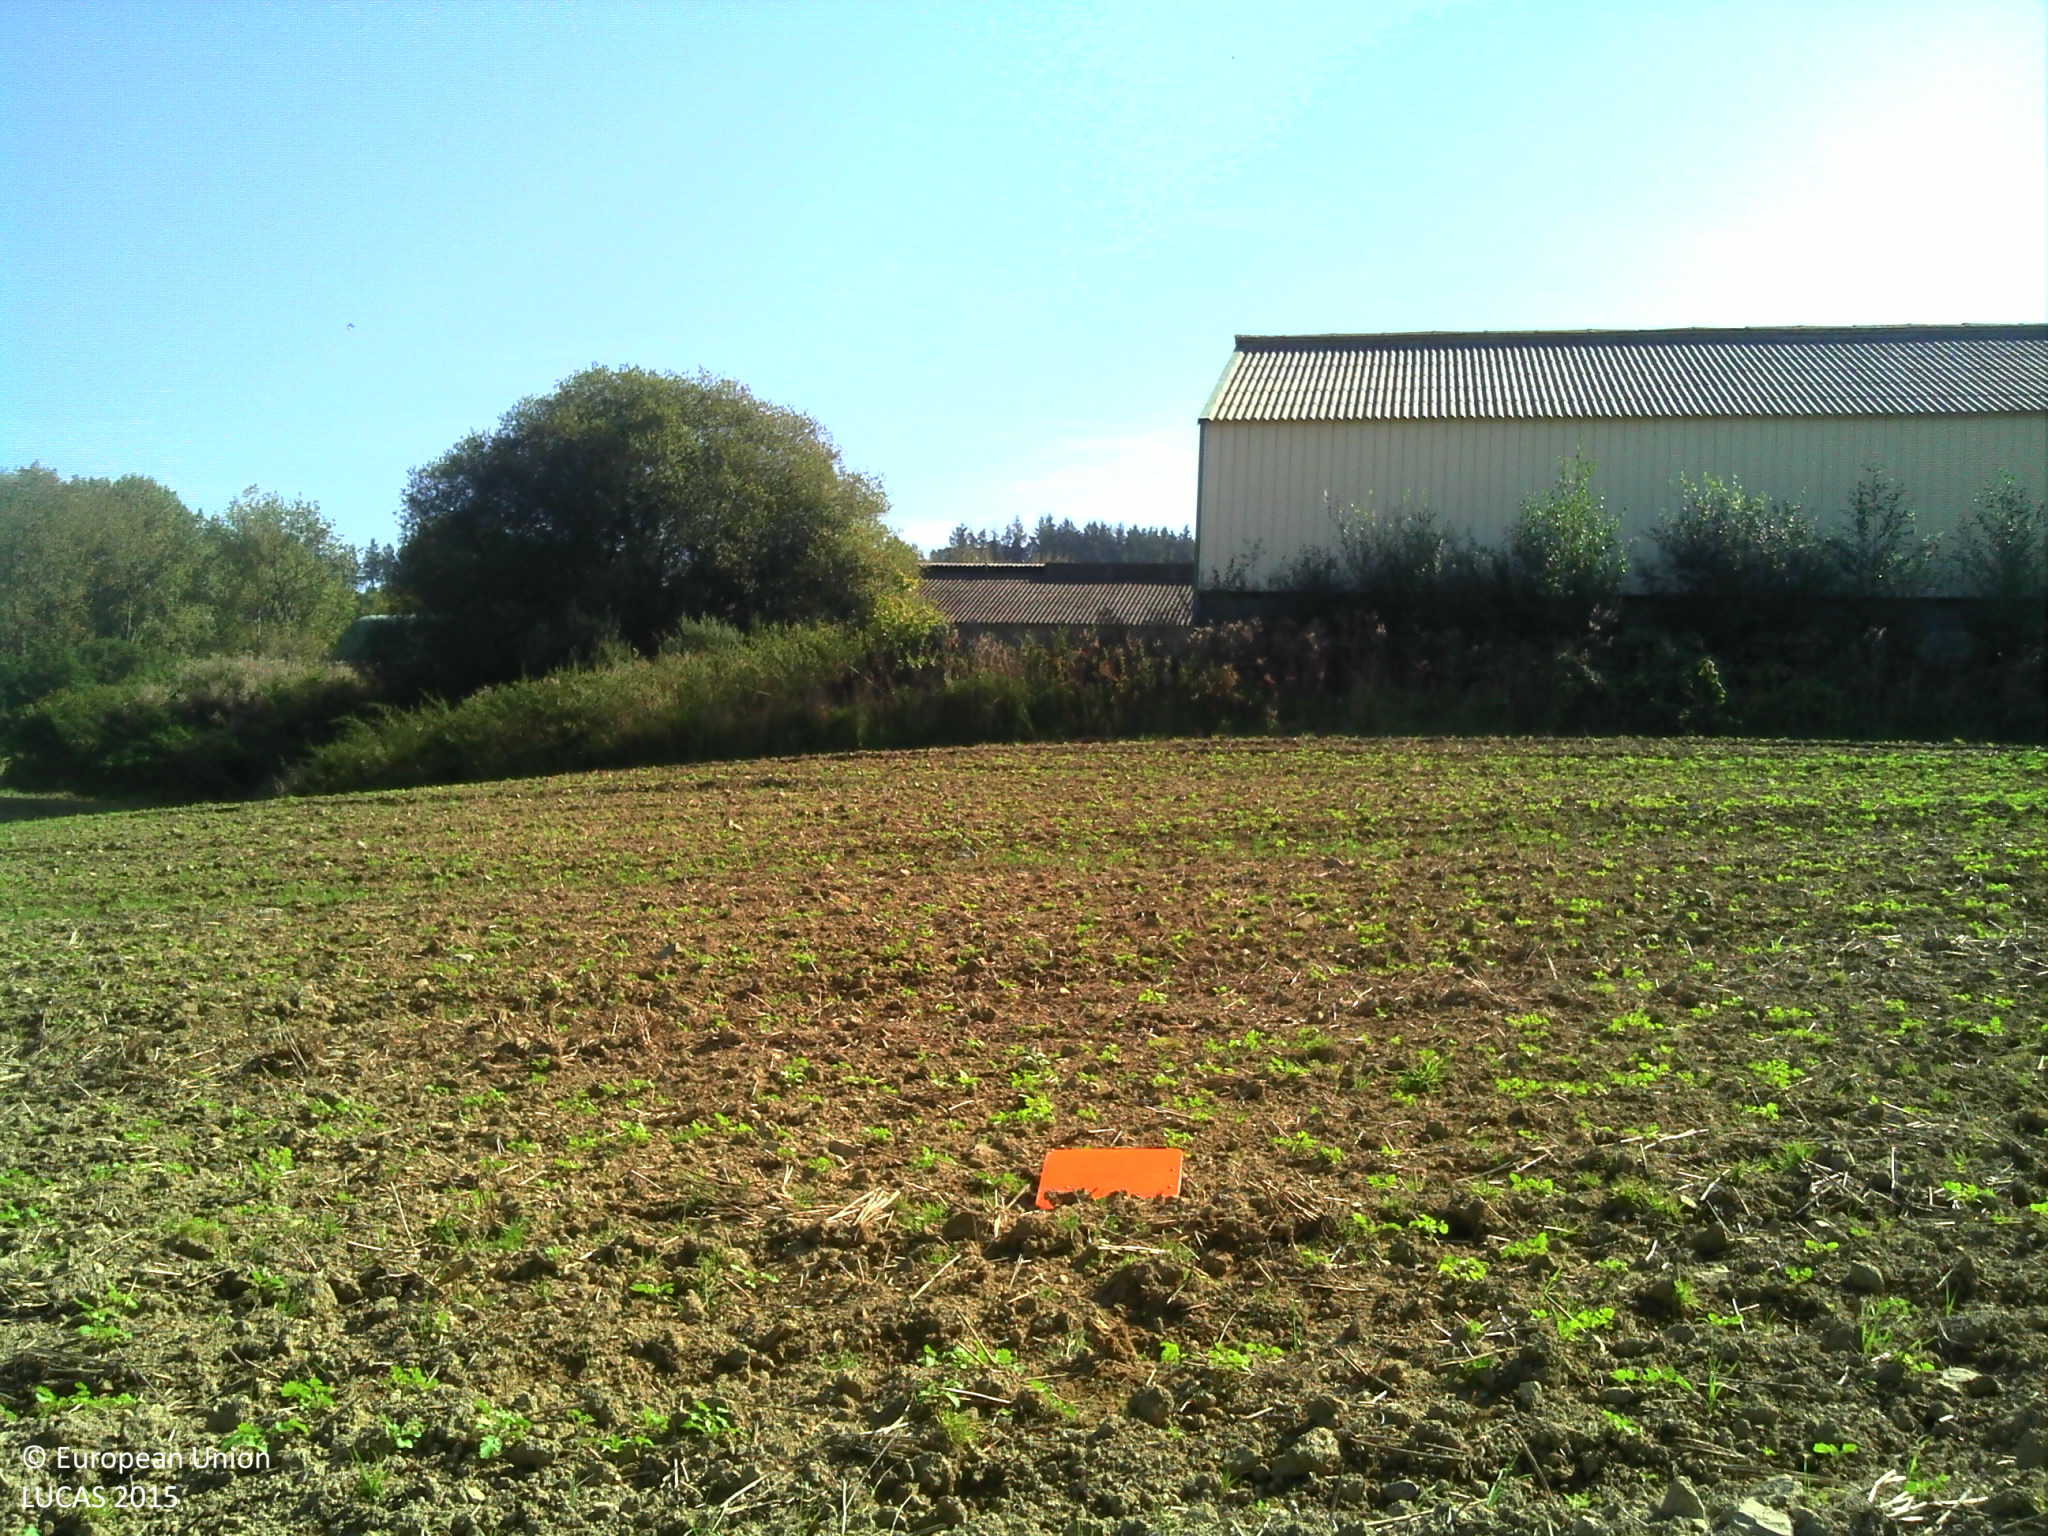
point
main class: Cropland
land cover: Rape and turnip rape
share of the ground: 10 - 25 %
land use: Agriculture (excluding fallow land and kitchen gardens)
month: October
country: FR
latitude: 48.4560
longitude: -3.1206
